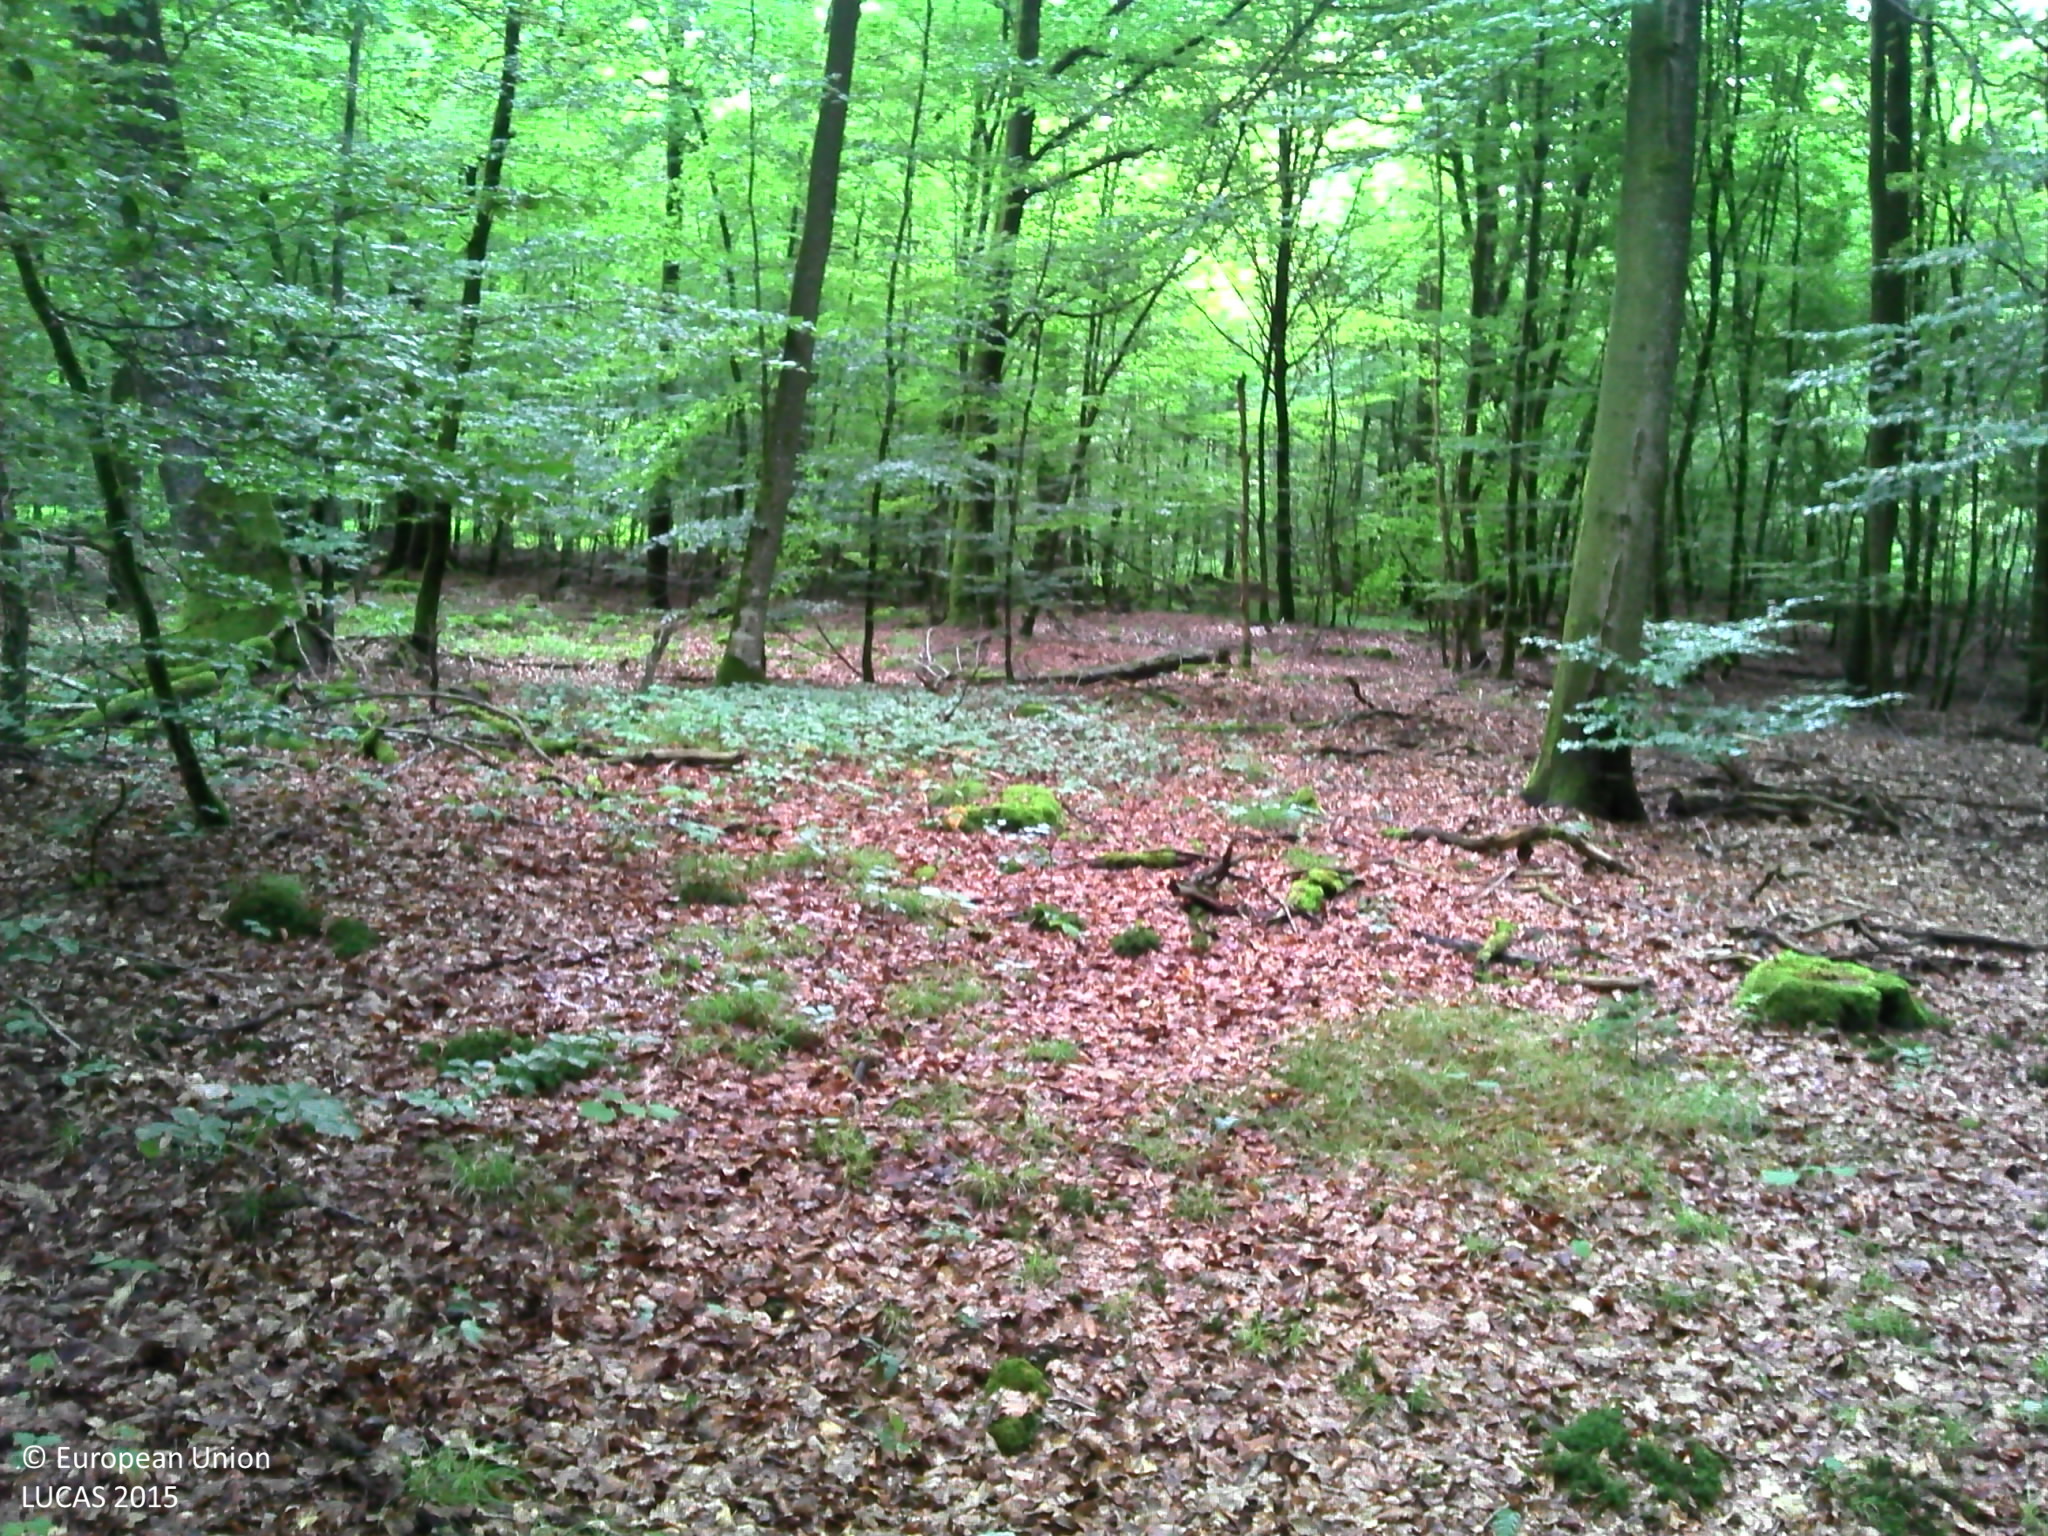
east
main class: Woodland
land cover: Broadleaved woodland
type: acidophilous oak and oak-birch forest
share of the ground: > 75 %
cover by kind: broadleaved forest trees 80 %, herbaceous plants 20 %
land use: Forestry
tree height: > 5 m
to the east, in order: Broadleaved woodland; Tracks; Broadleaved woodland
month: July
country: BE
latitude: 49.7281
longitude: 5.3230
